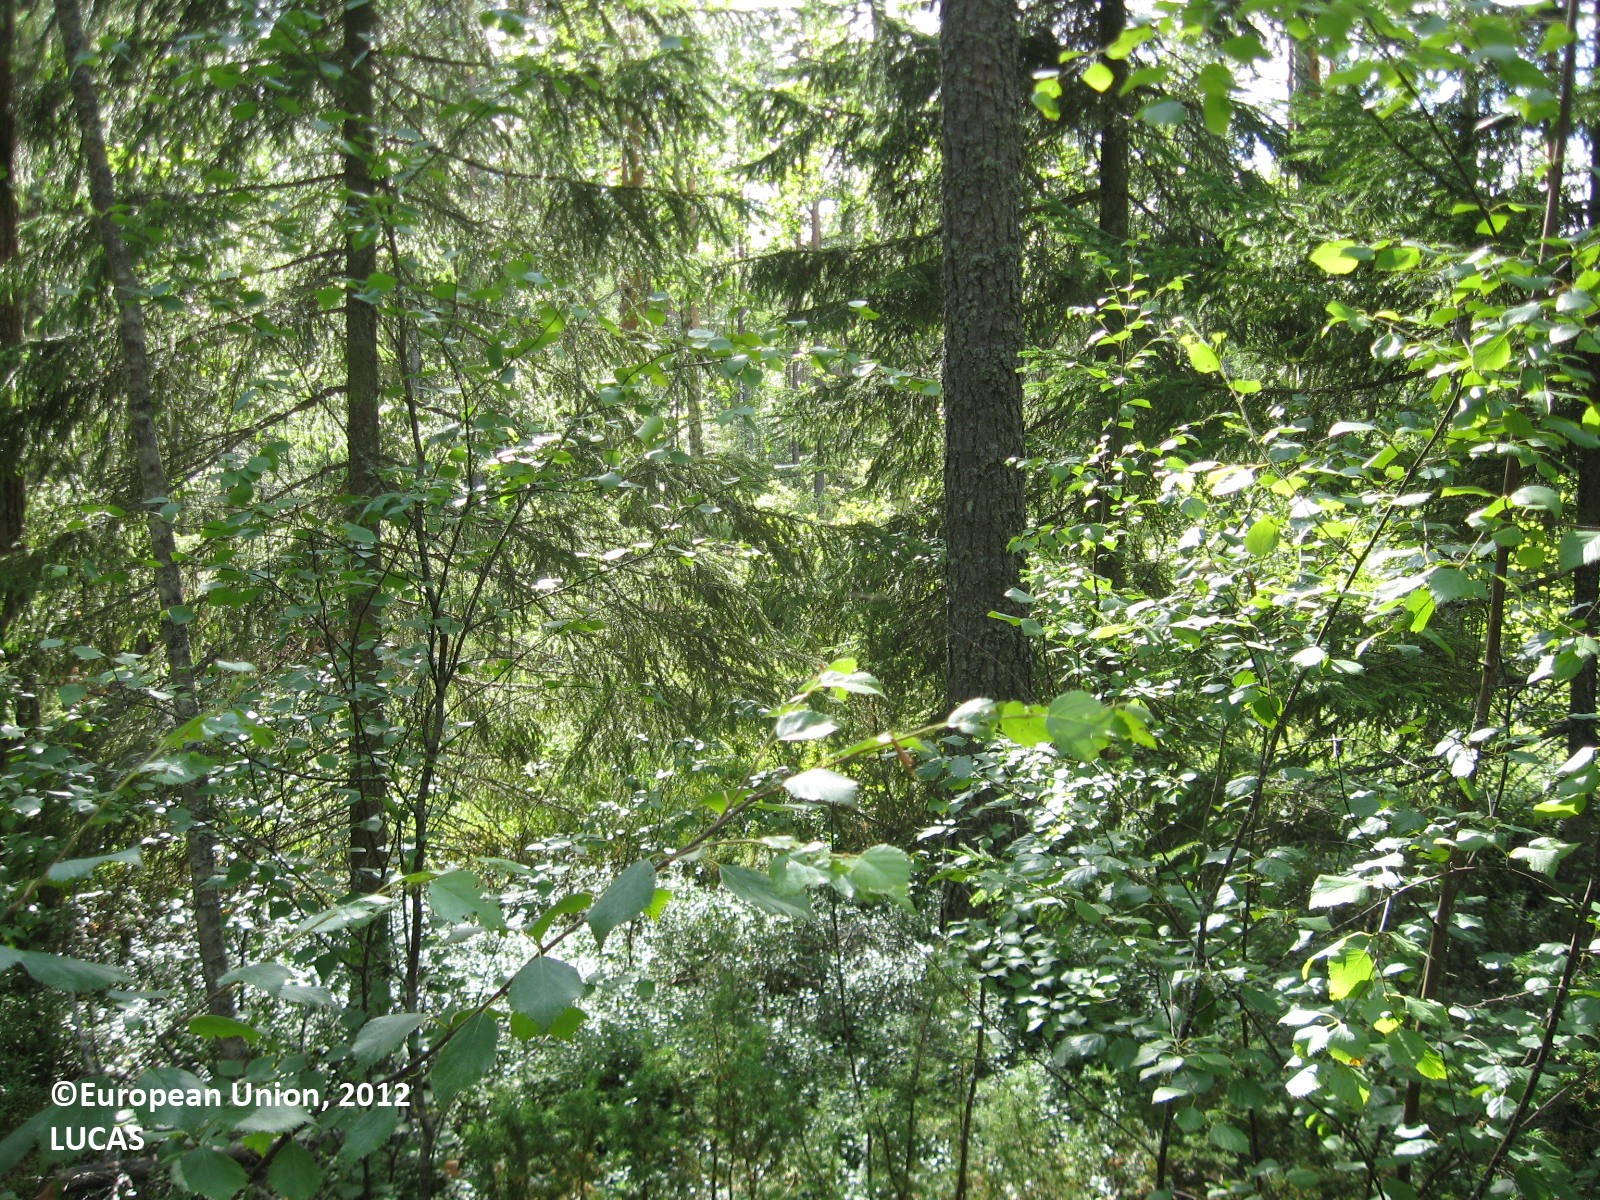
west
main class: Woodland
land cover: Pine dominated mixed woodland
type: boreal forest
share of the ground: > 75 %
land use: Forestry
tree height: > 5 m
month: July
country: FI
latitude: 62.0751
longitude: 21.5507
